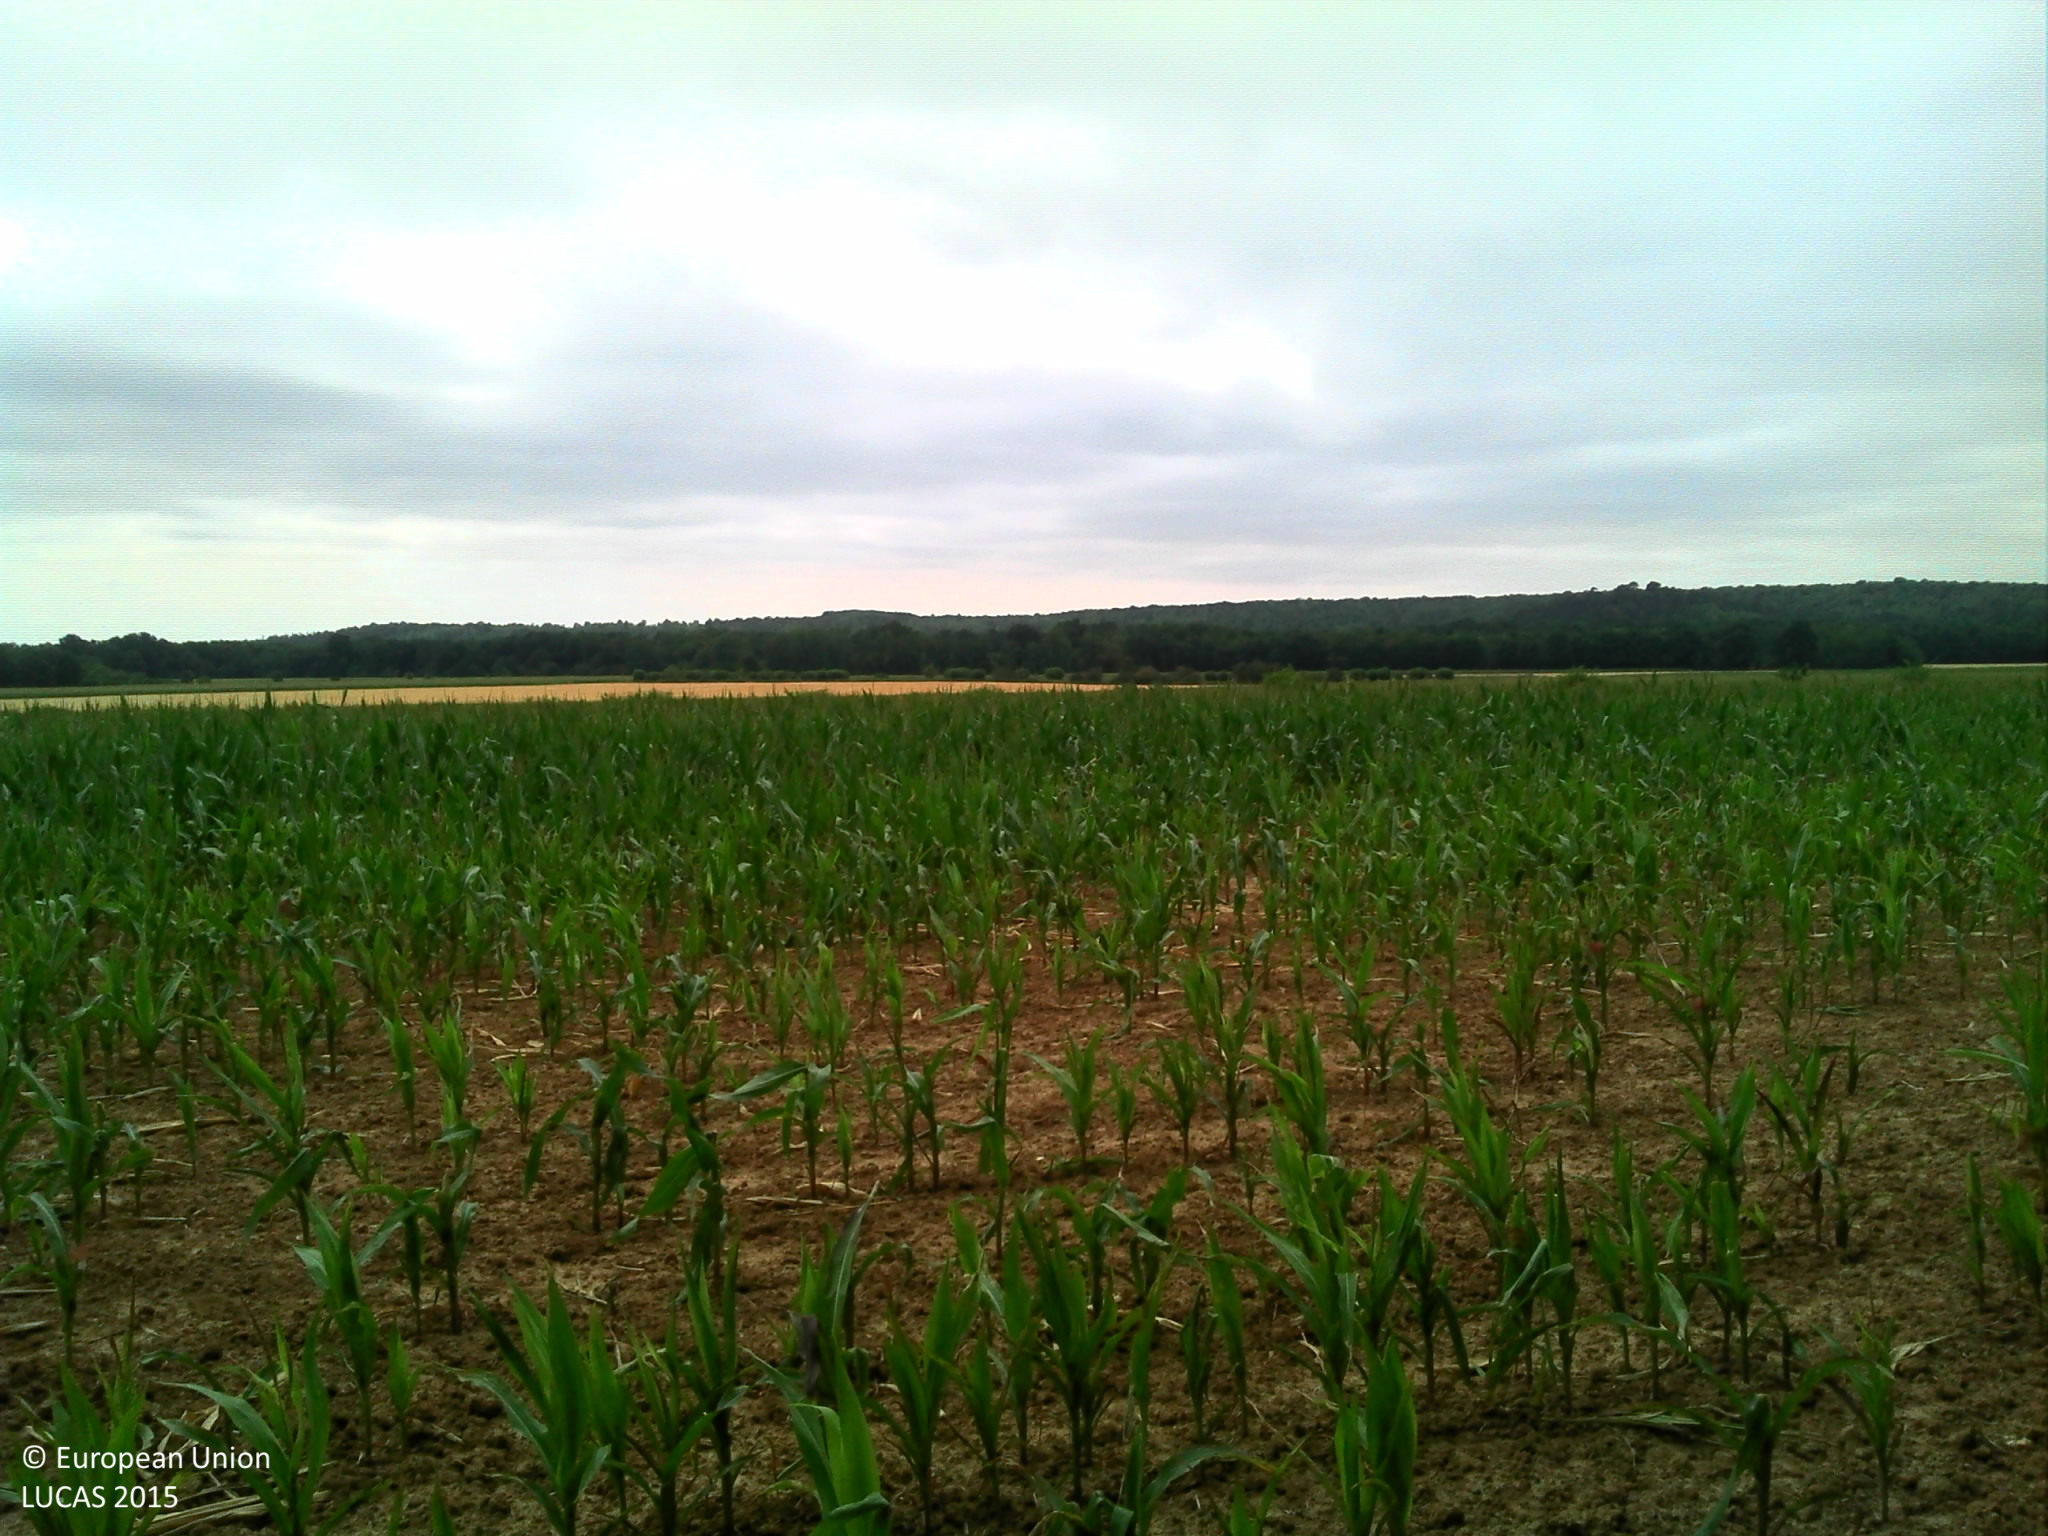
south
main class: Cropland
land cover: Maize
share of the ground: 10 - 25 %
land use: Agriculture (excluding fallow land and kitchen gardens)
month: July
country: FR
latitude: 48.4387
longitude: 2.5144
